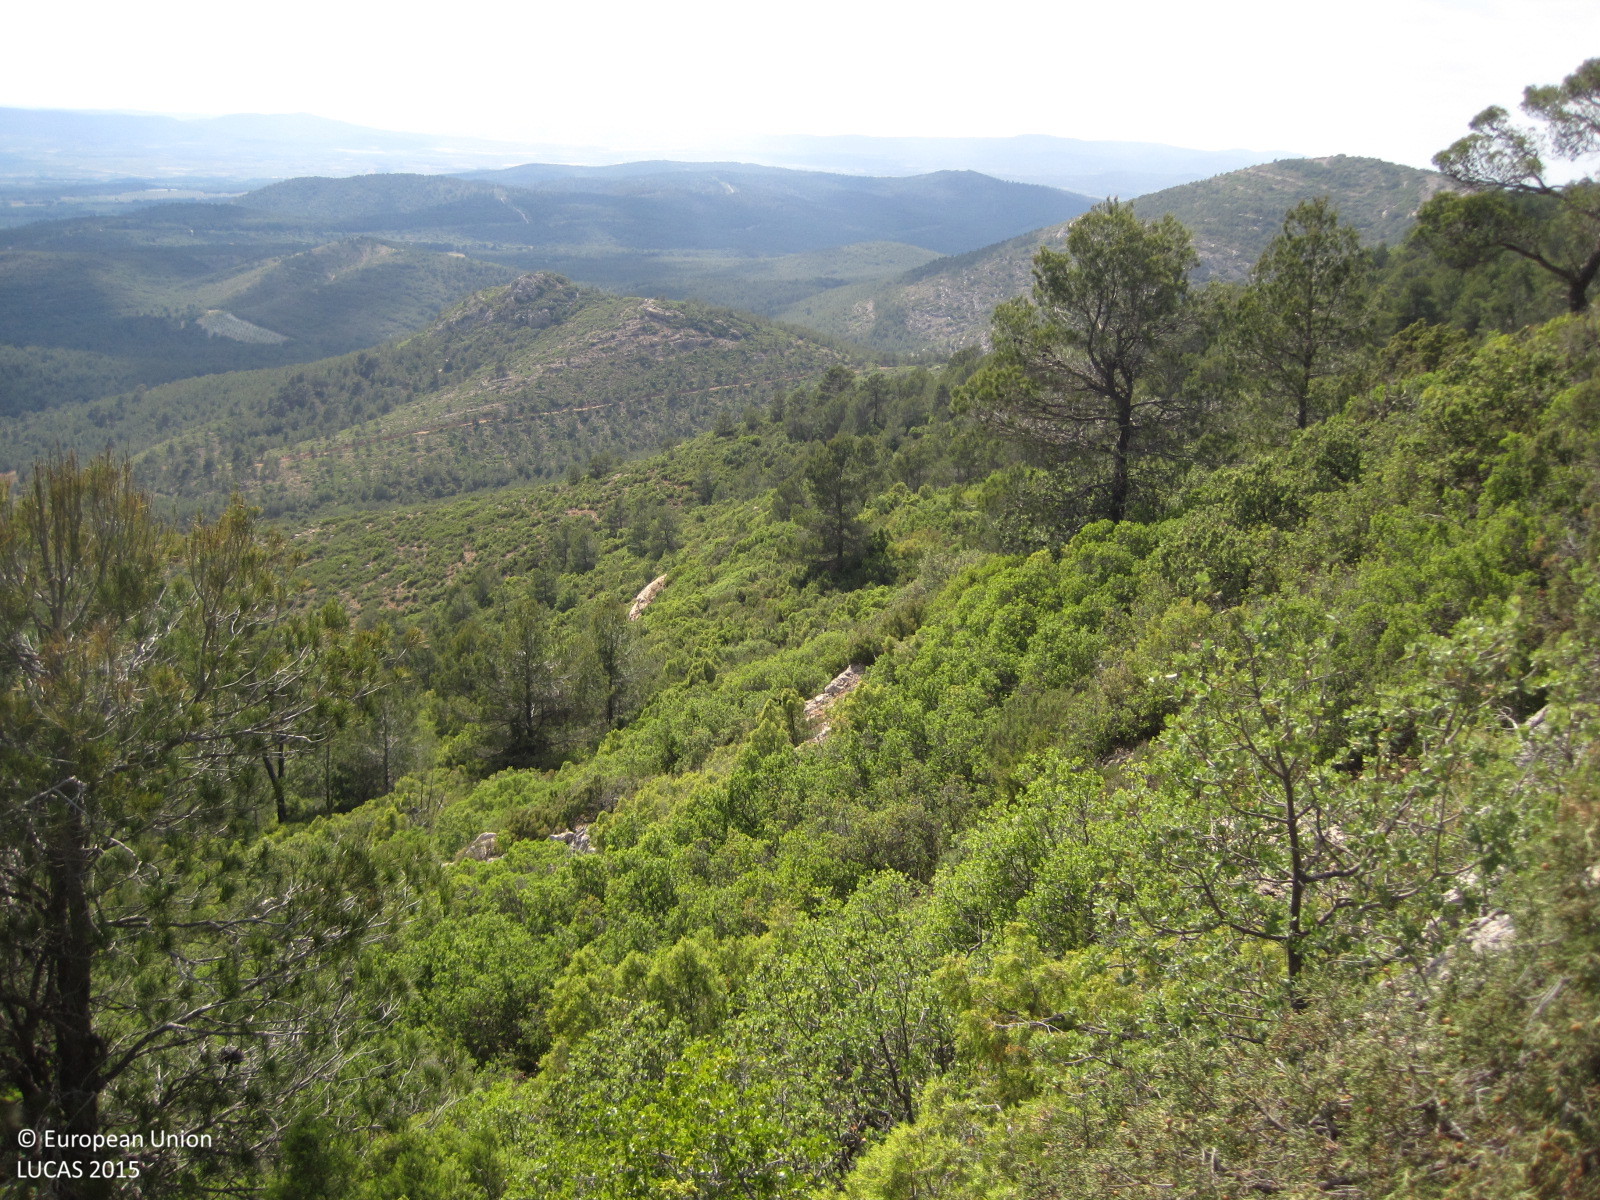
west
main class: Woodland
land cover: Pine dominated coniferous woodland
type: coniferous forest of the mediterranean region
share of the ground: 50 - 75 %
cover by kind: shrubs 50 %, coniferous forest trees 30 %, broadleaved forest trees 10 %, herbaceous plants 10 %
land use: Semi-natural and natural areas not in use
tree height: > 5 m
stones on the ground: > 50 %
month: May
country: ES
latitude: 39.6473
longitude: -1.1559
